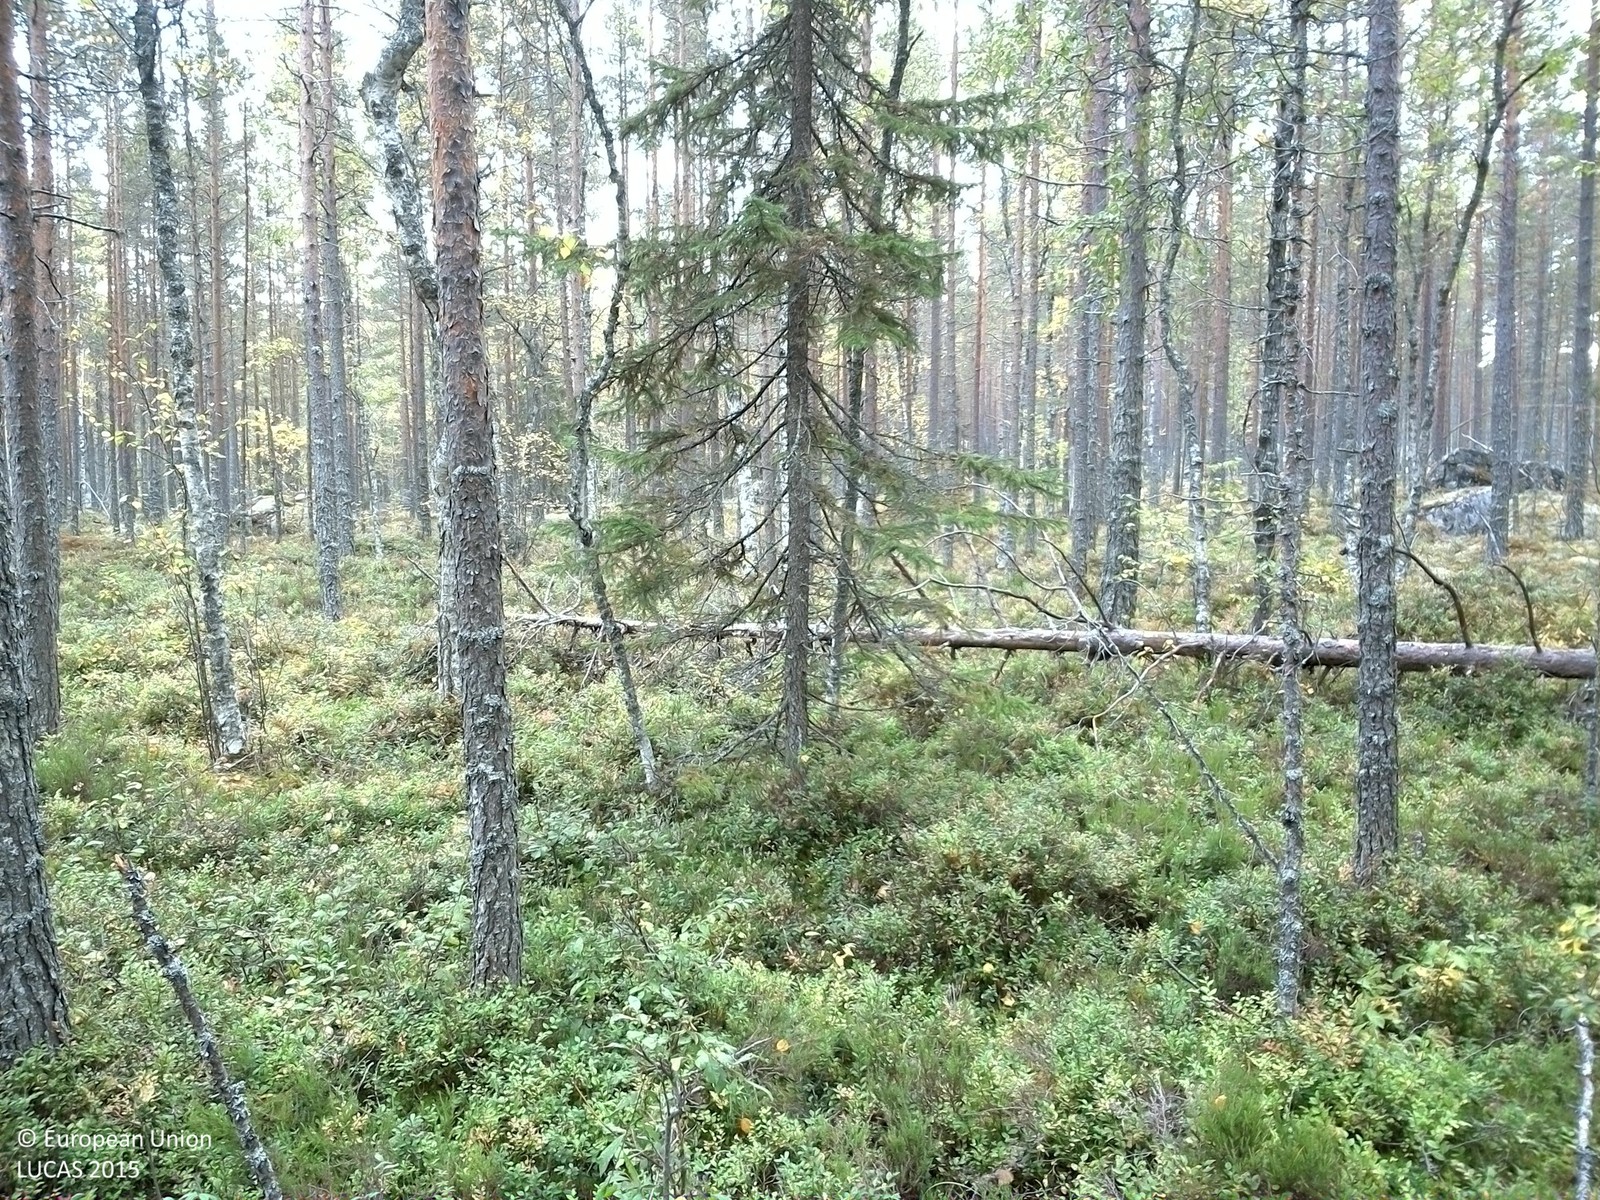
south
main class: Woodland
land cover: Pine dominated mixed woodland
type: boreal forest
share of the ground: 50 - 75 %
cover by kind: coniferous forest trees 45 %, broadleaved forest trees 25 %, shrubs 20 %, lichens and mosses 5 %, consolidated bare surface 5 %
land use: Forestry
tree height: > 5 m
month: September
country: SE
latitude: 61.2712
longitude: 15.3375
